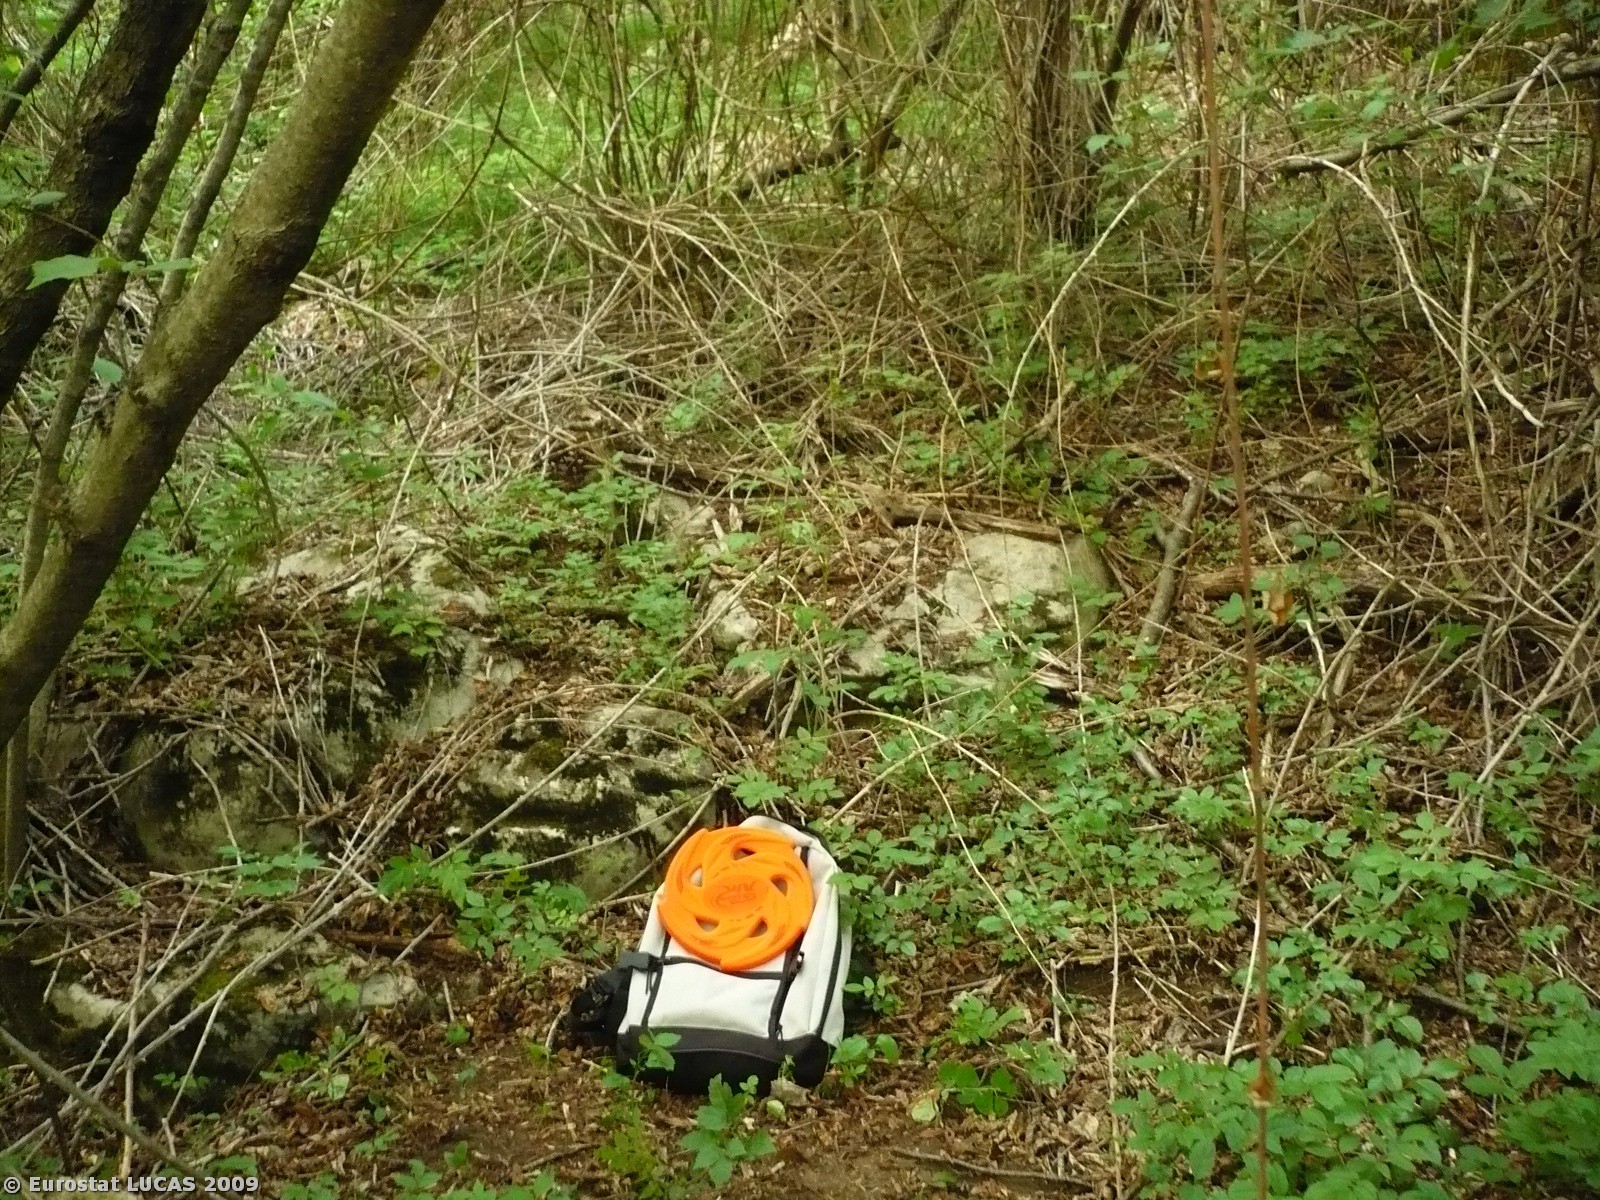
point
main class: Woodland
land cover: Broadleaved woodland
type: thermophilous deciduous forest
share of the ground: > 75 %
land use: Agriculture (excluding fallow land and kitchen gardens)
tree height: > 5 m
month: May
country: SI
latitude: 46.0535
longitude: 13.6799
